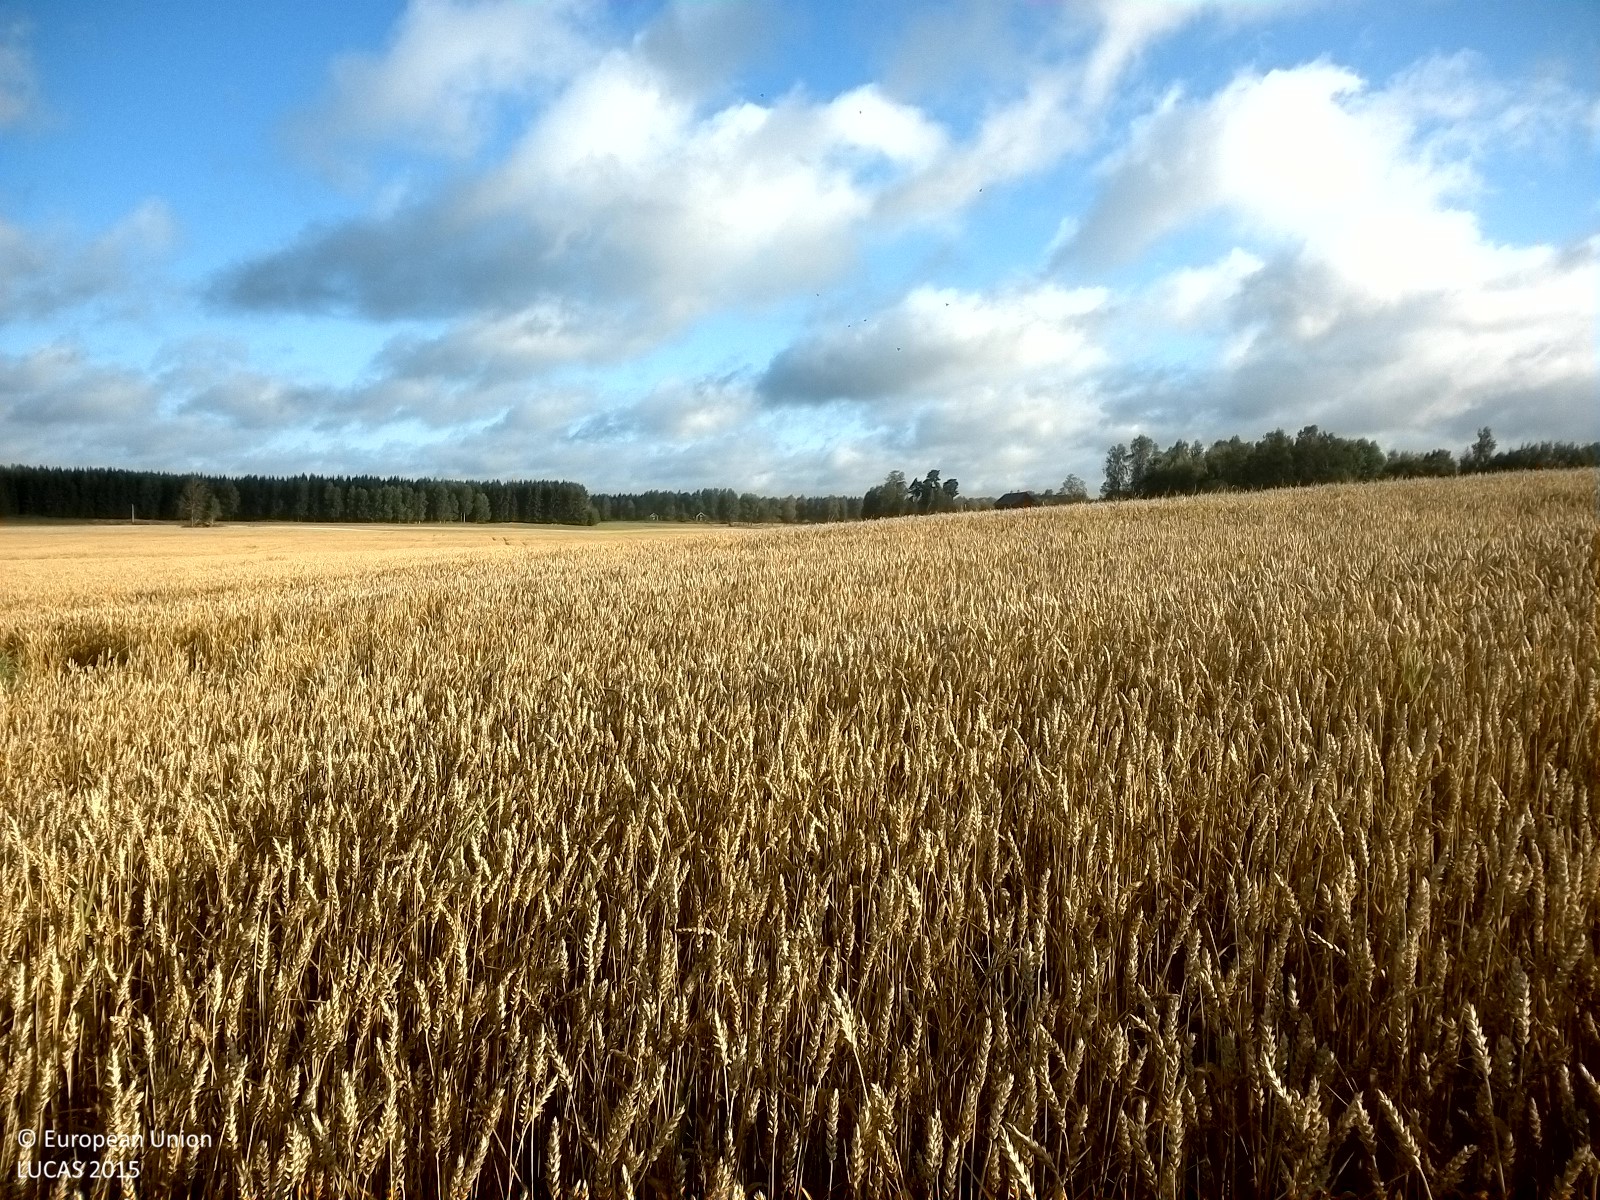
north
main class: Cropland
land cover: Common wheat
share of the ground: > 75 %
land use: Agriculture (excluding fallow land and kitchen gardens)
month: August
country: SE
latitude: 58.9201
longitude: 15.4635
